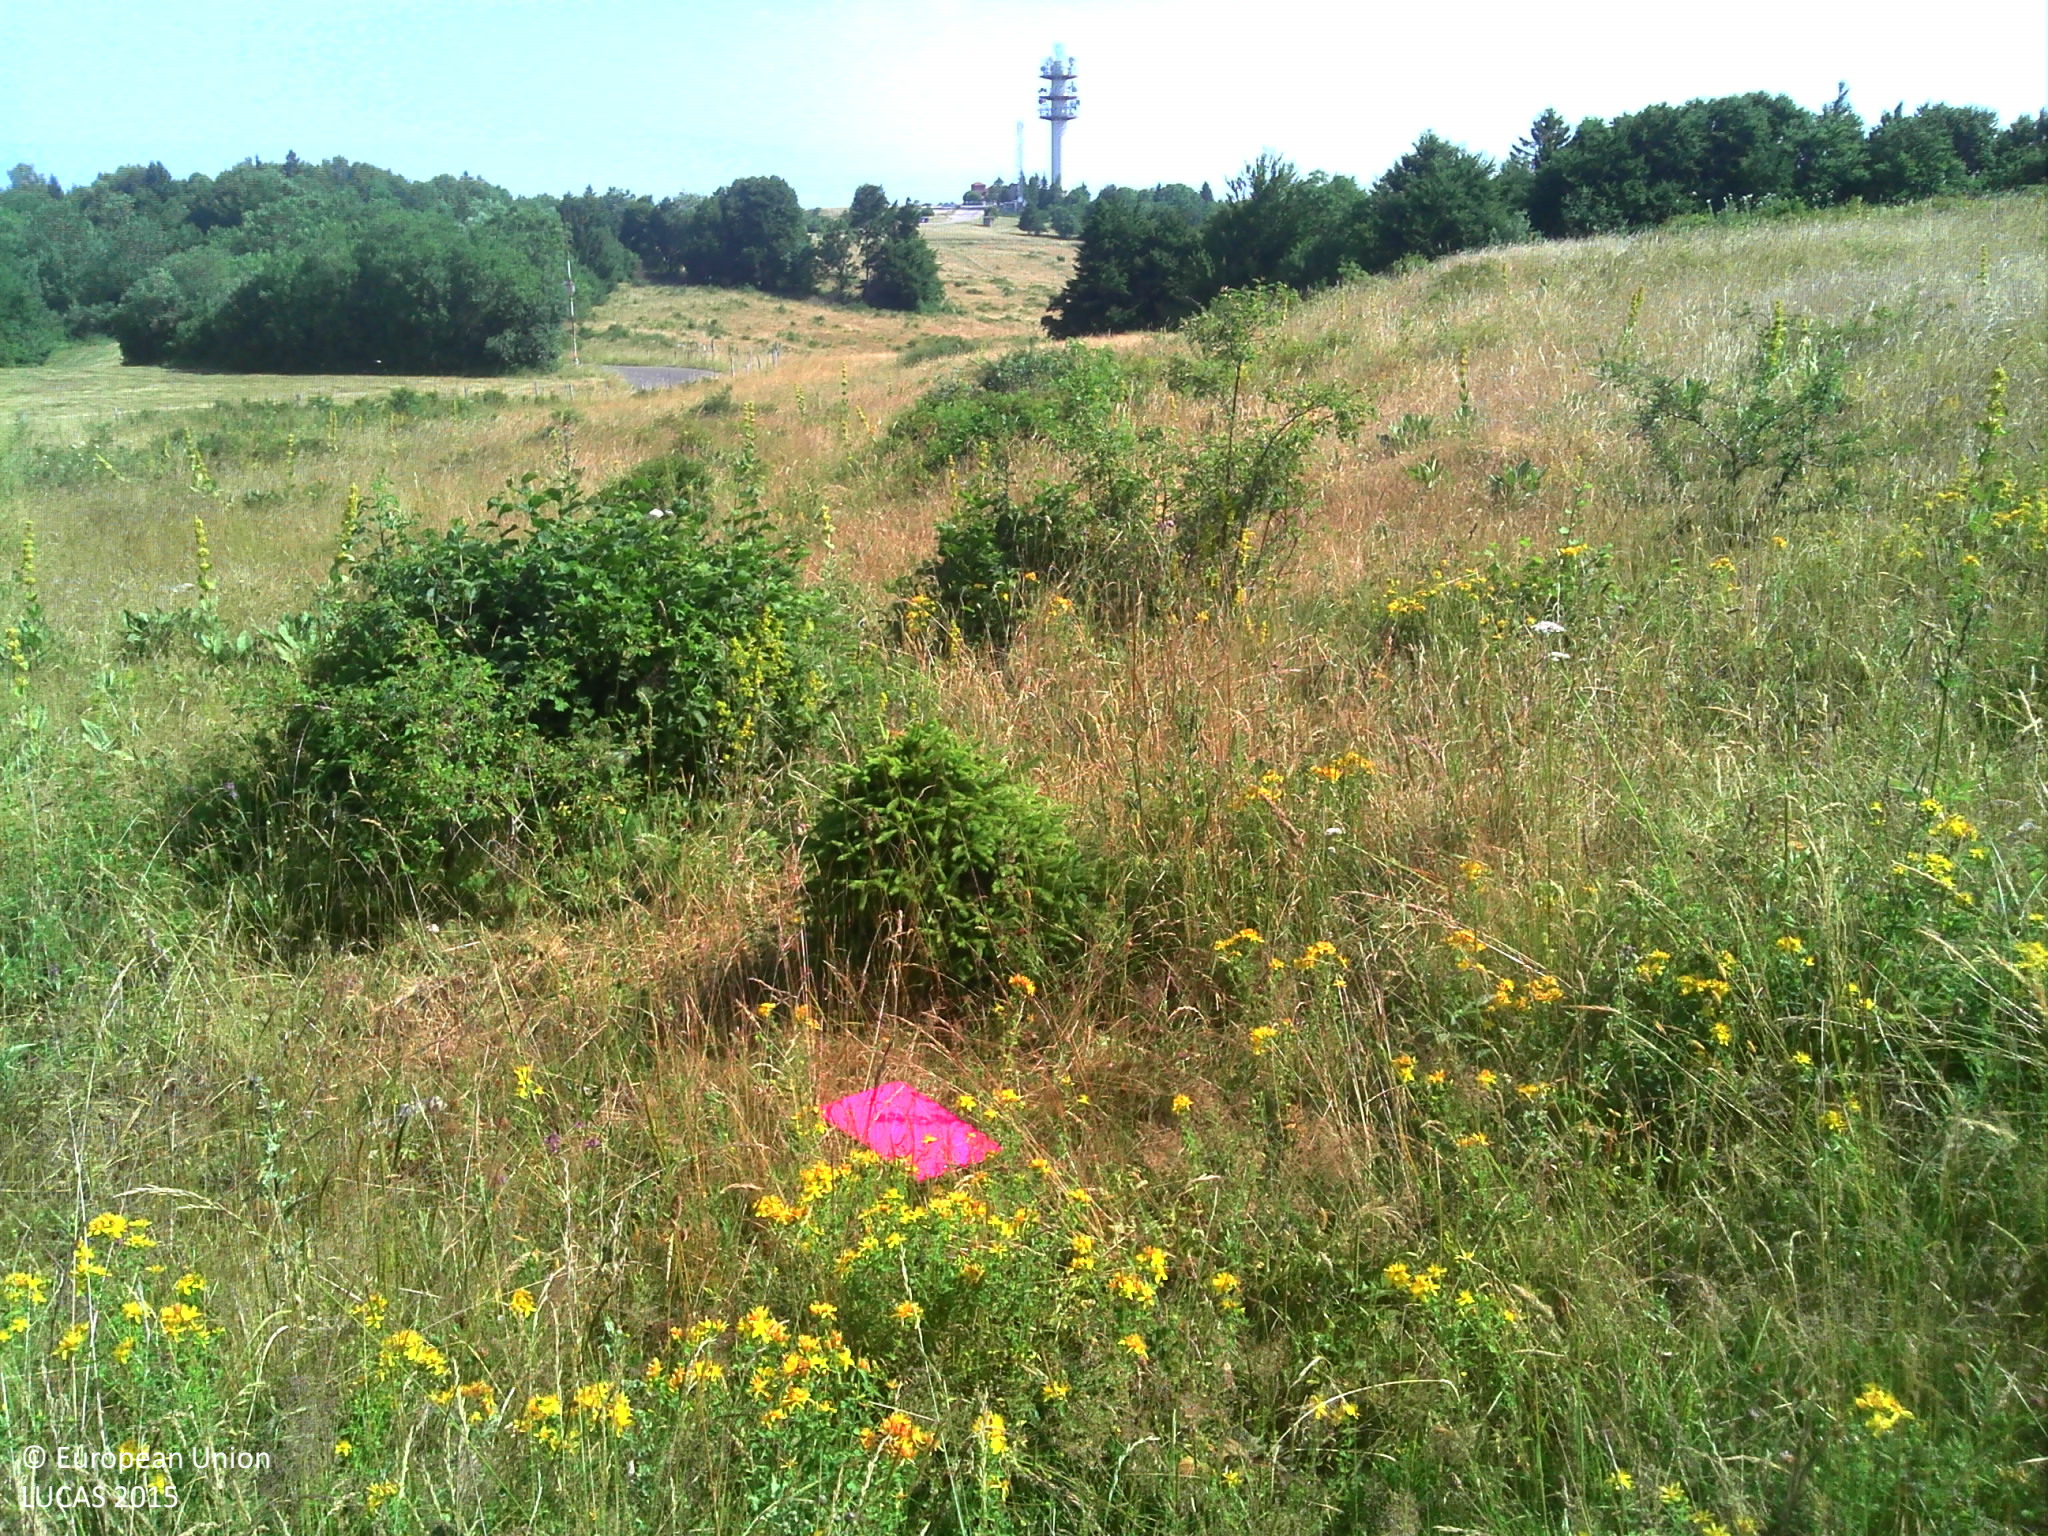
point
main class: Grassland
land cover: Grassland with sparse tree/shrub cover
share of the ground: > 75 %
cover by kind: herbaceous plants 90 %, coniferous forest trees 5 %, shrubs 5 %
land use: Agriculture (excluding fallow land and kitchen gardens)
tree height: < 5 m
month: July
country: FR
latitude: 46.1389
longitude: 6.1848
